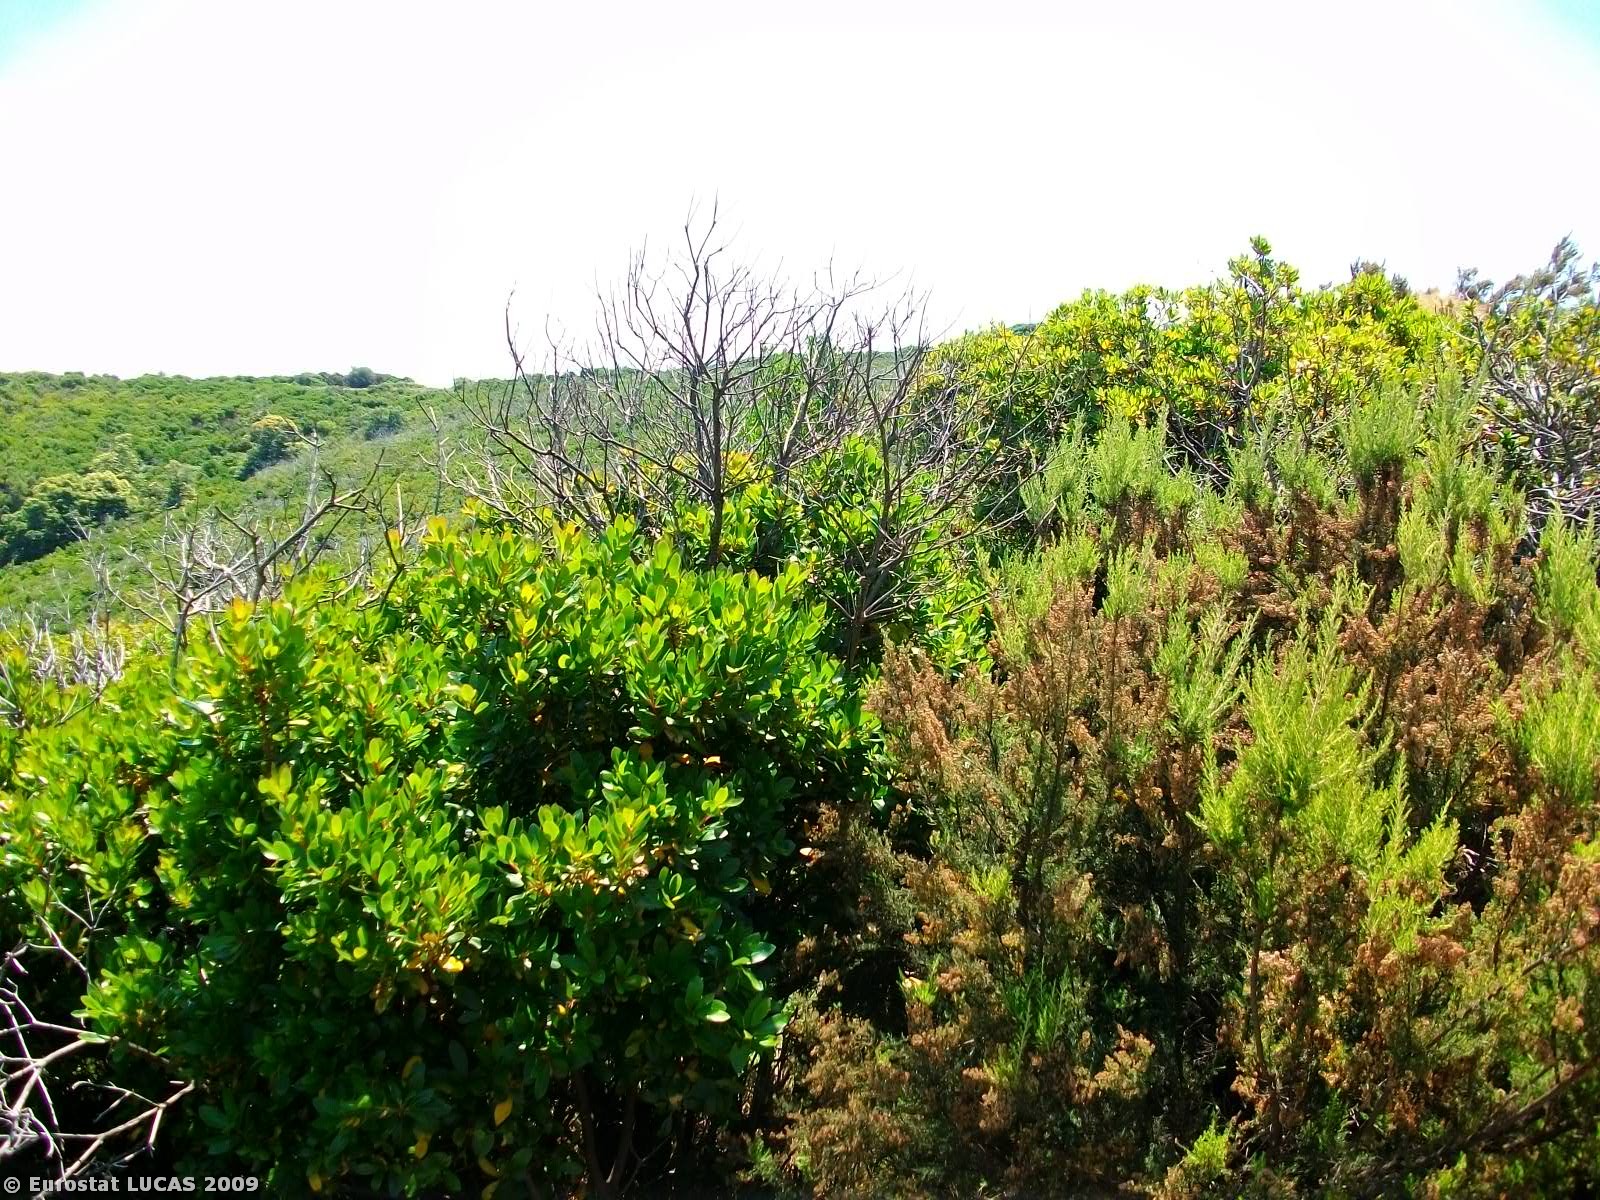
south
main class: Shrubland
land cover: Shrubland with sparse tree cover
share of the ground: > 75 %
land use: Agriculture (excluding fallow land and kitchen gardens)
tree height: > 5 m
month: June
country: GR
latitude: 39.1994
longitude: 23.2508
